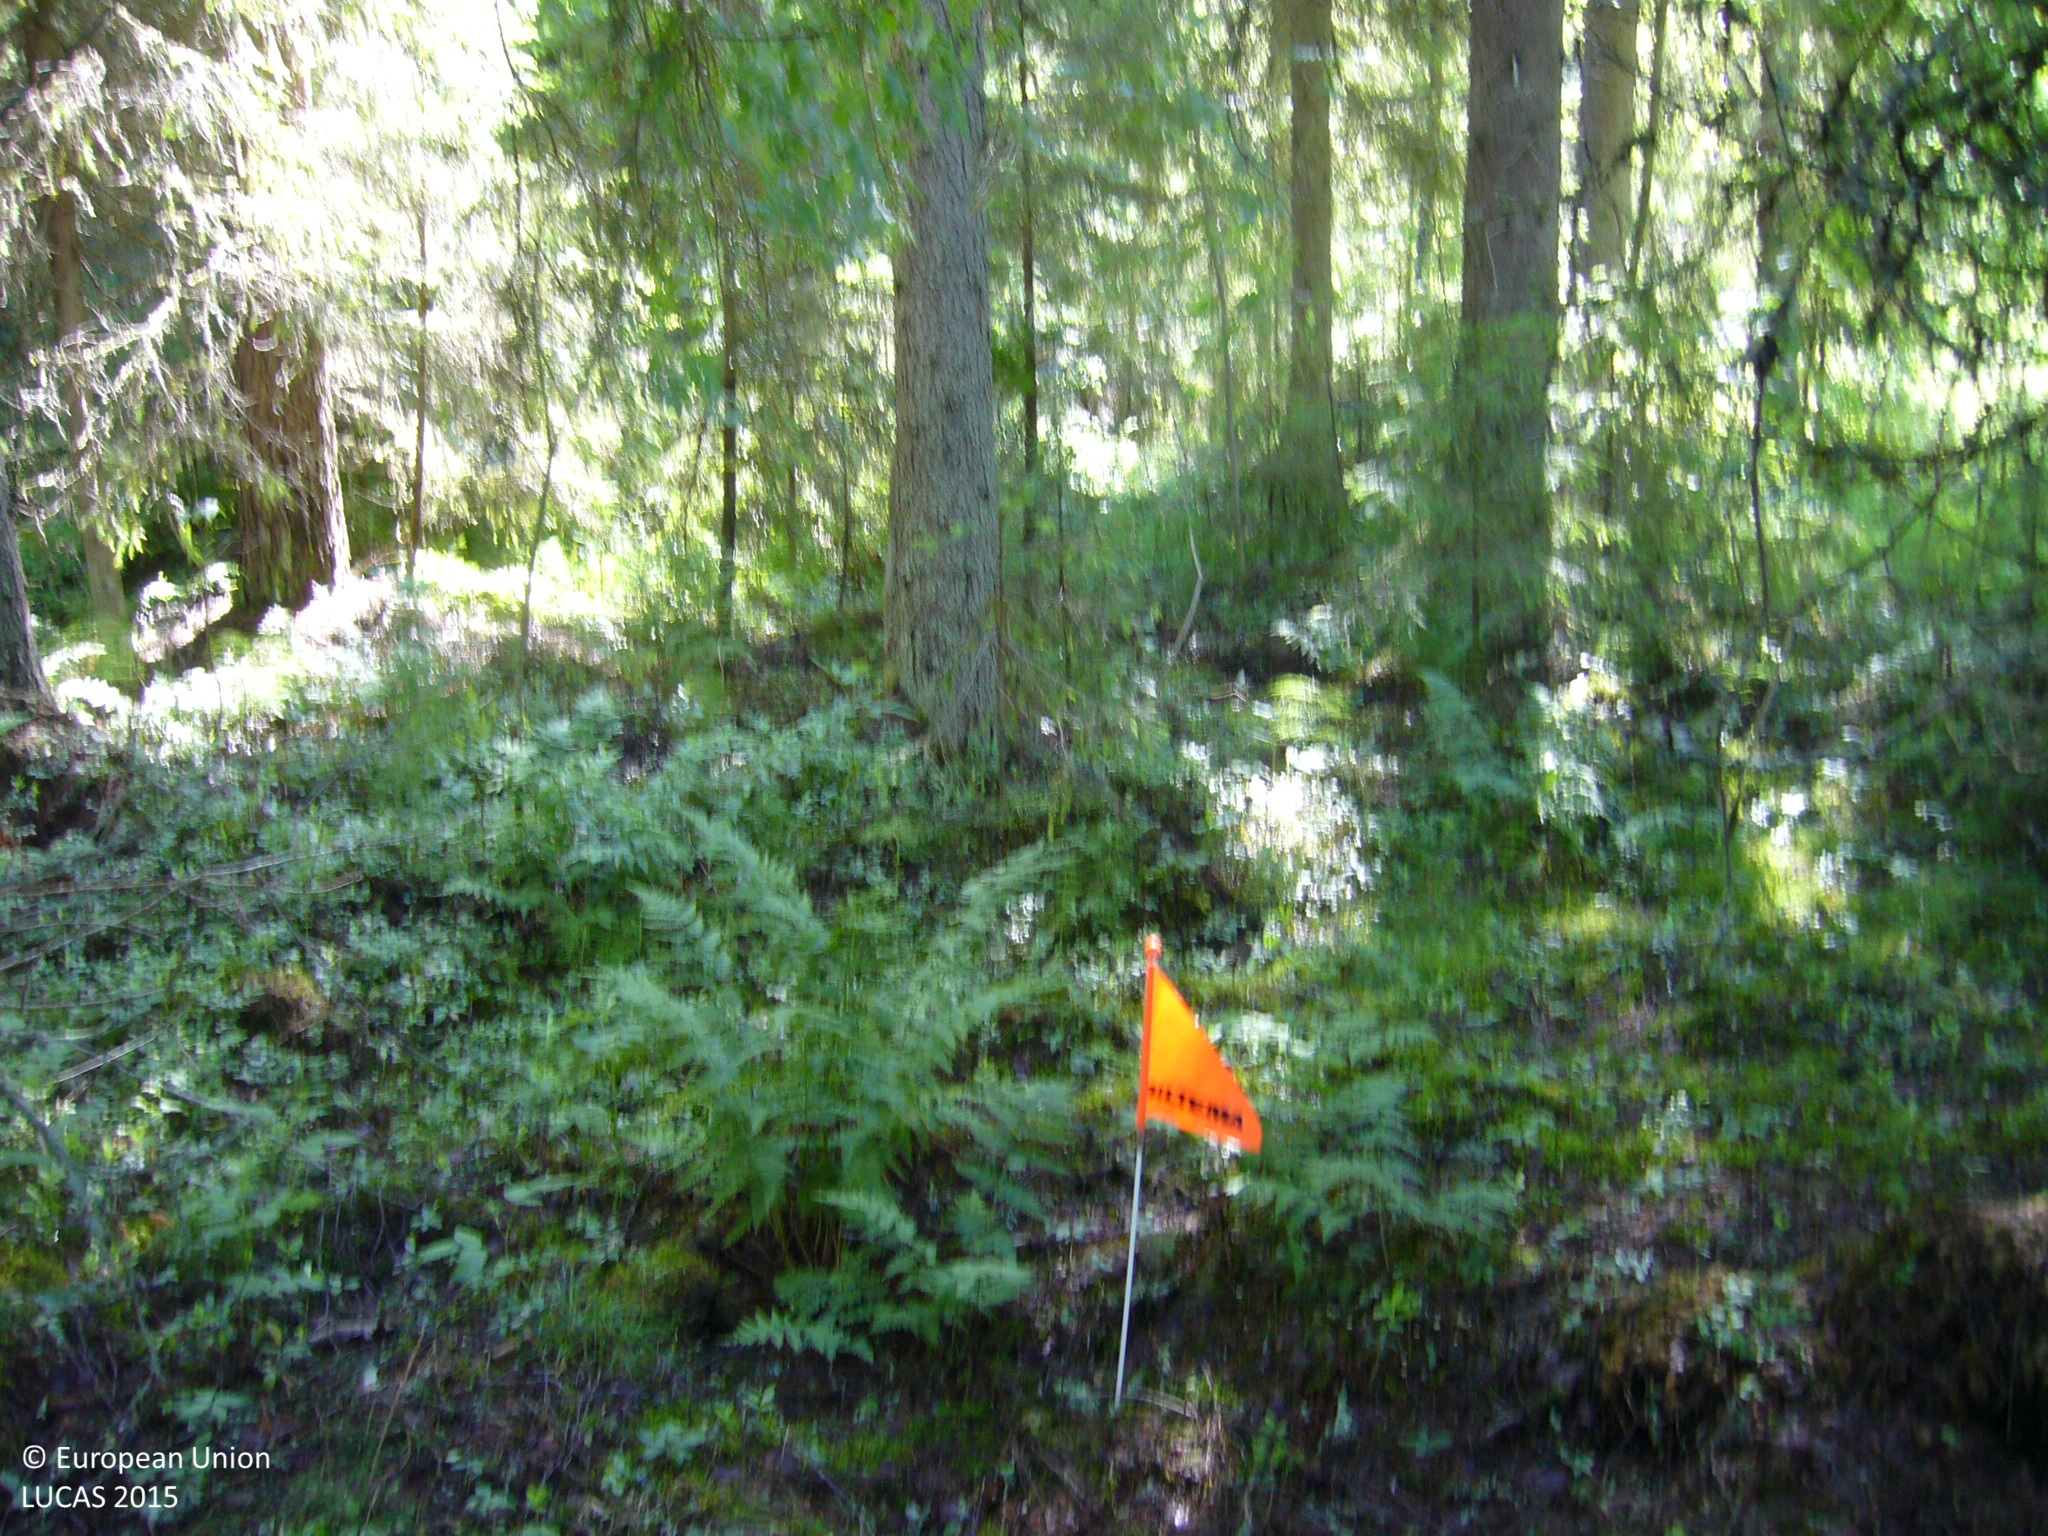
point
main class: Woodland
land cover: Spruce dominated coniferous woodland
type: boreal forest
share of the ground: > 75 %
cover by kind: coniferous forest trees 90 %, shrubs 5 %, herbaceous plants 5 %
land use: Forestry
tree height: > 5 m
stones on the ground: < 10 %
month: July
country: FI
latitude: 63.5489
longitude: 26.2783
